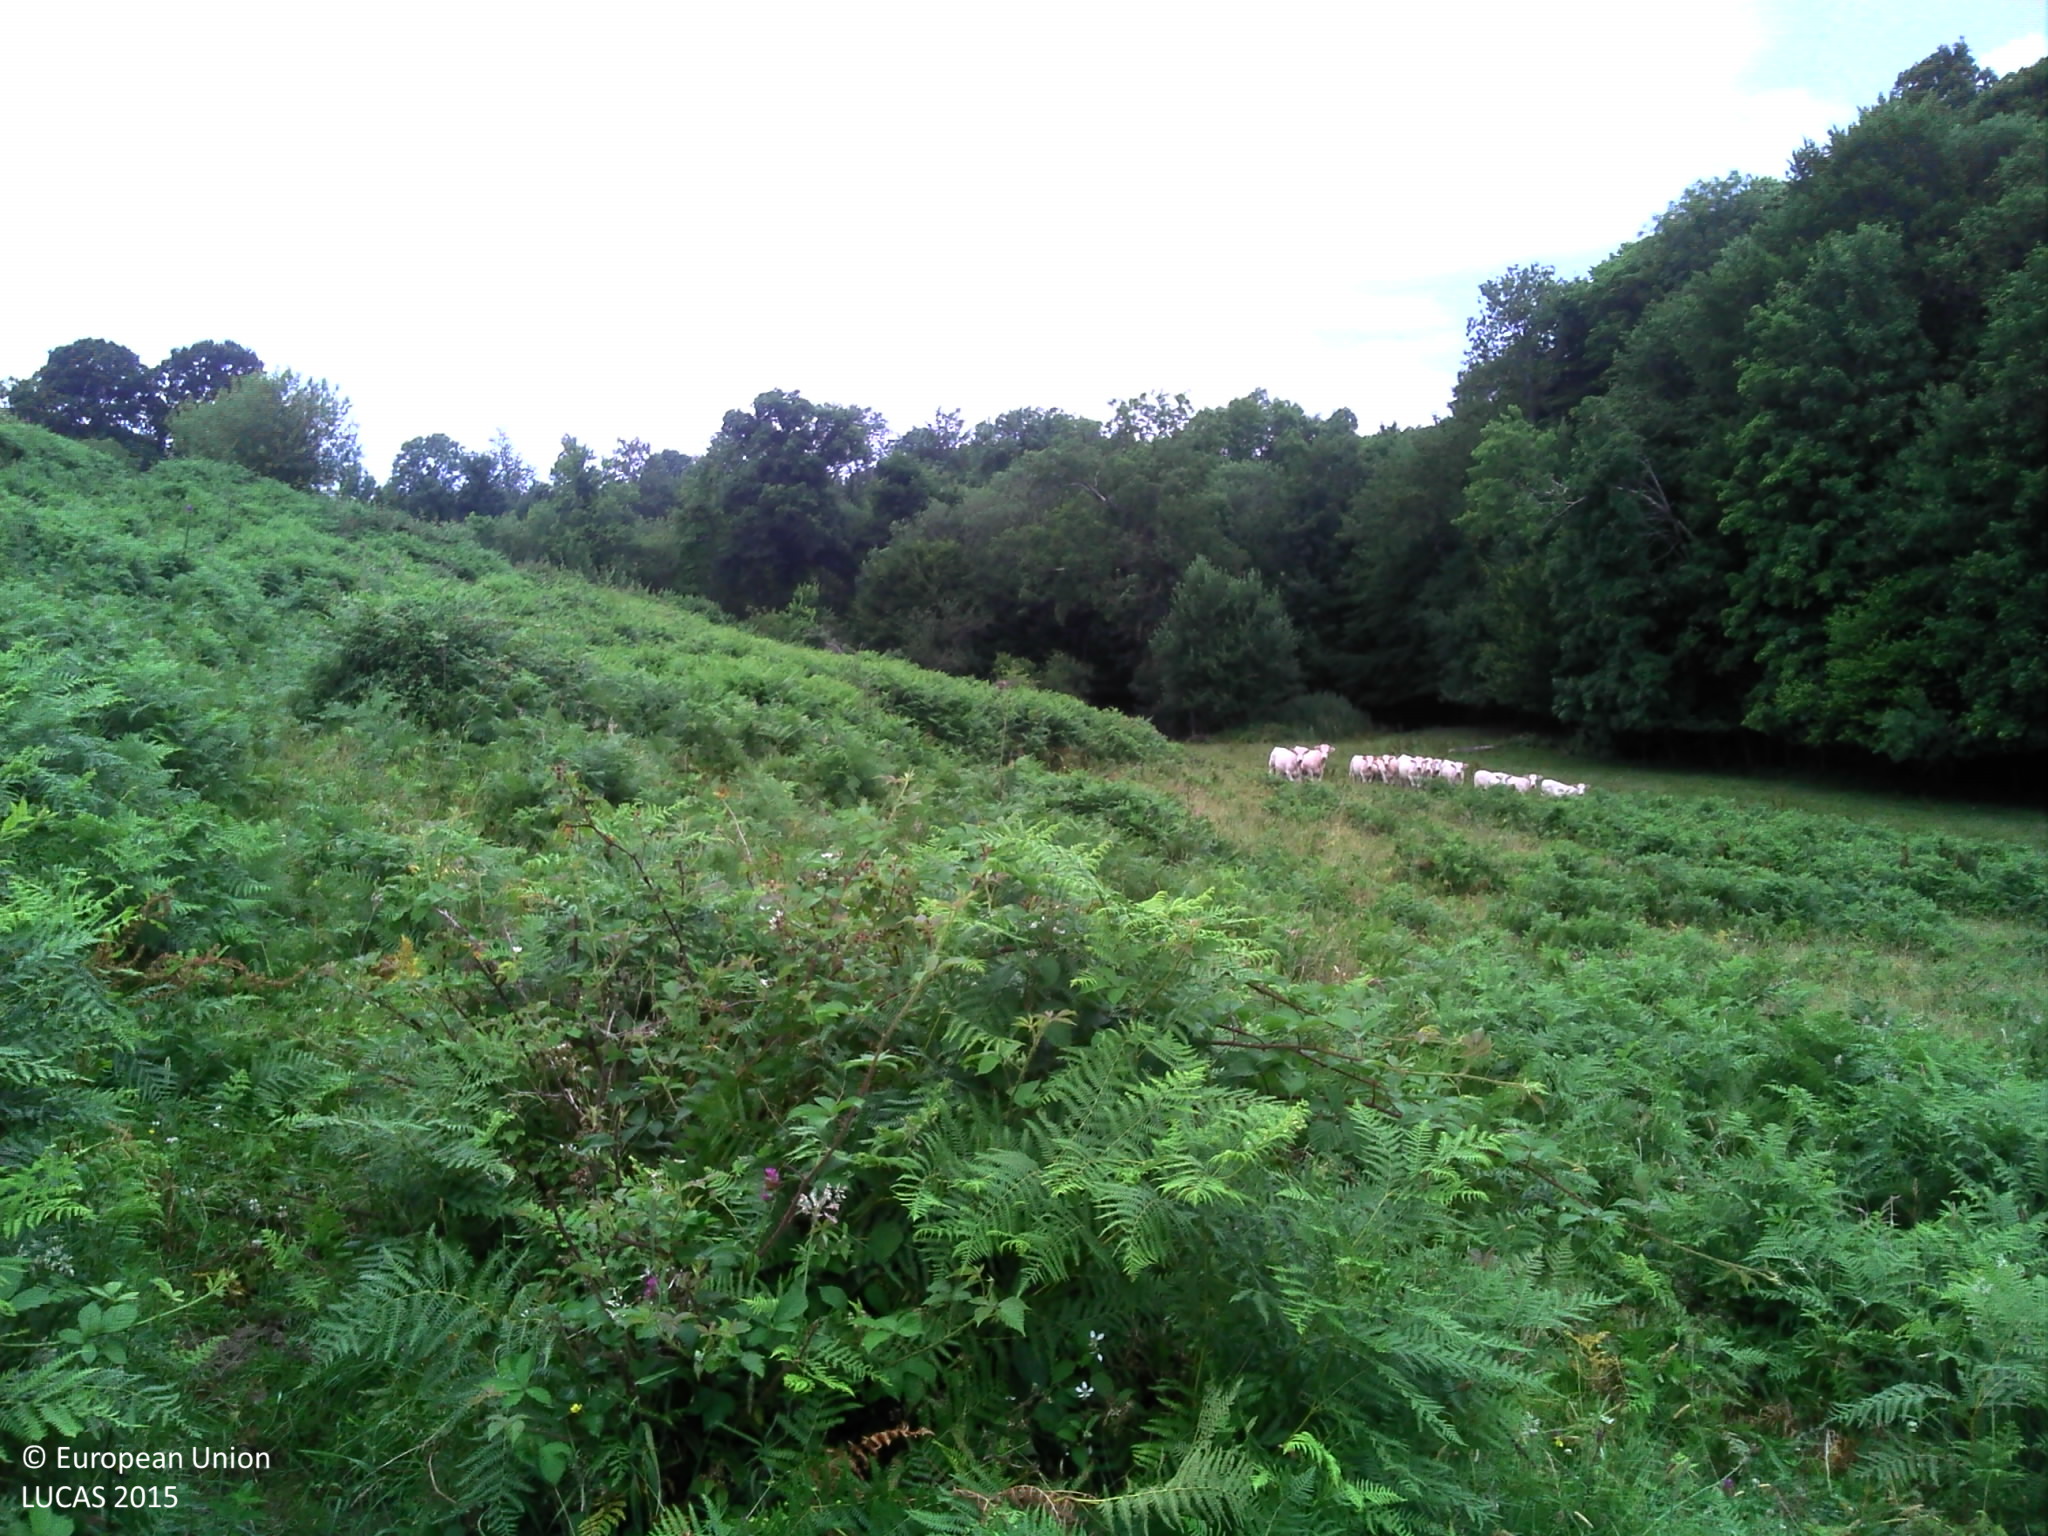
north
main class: Grassland
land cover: Spontaneously vegetated surfaces
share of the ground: > 75 %
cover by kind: herbaceous plants 100 %
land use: Agriculture (excluding fallow land and kitchen gardens)
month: July
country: FR
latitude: 49.3371
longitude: 0.3246
